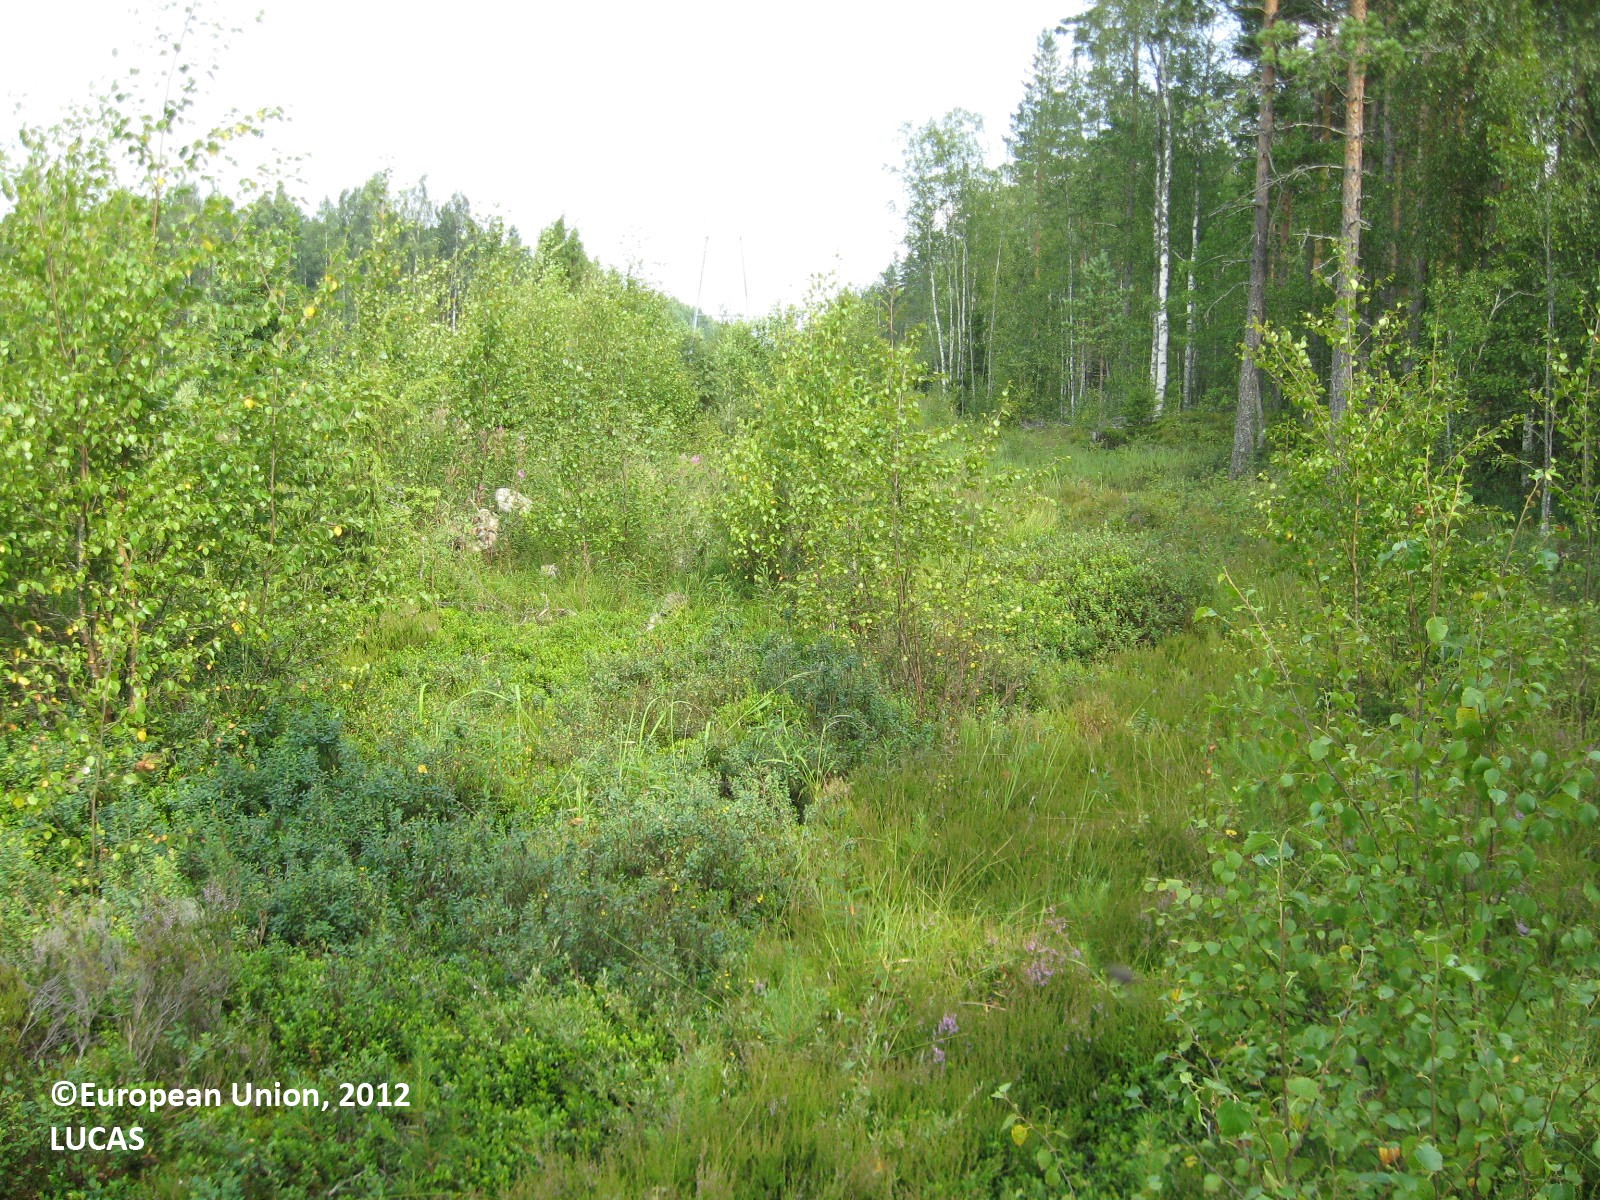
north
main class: Woodland
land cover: Other mixed woodland
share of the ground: 50 - 75 %
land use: Energy production
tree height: < 5 m
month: July
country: FI
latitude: 61.9518
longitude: 22.3927
